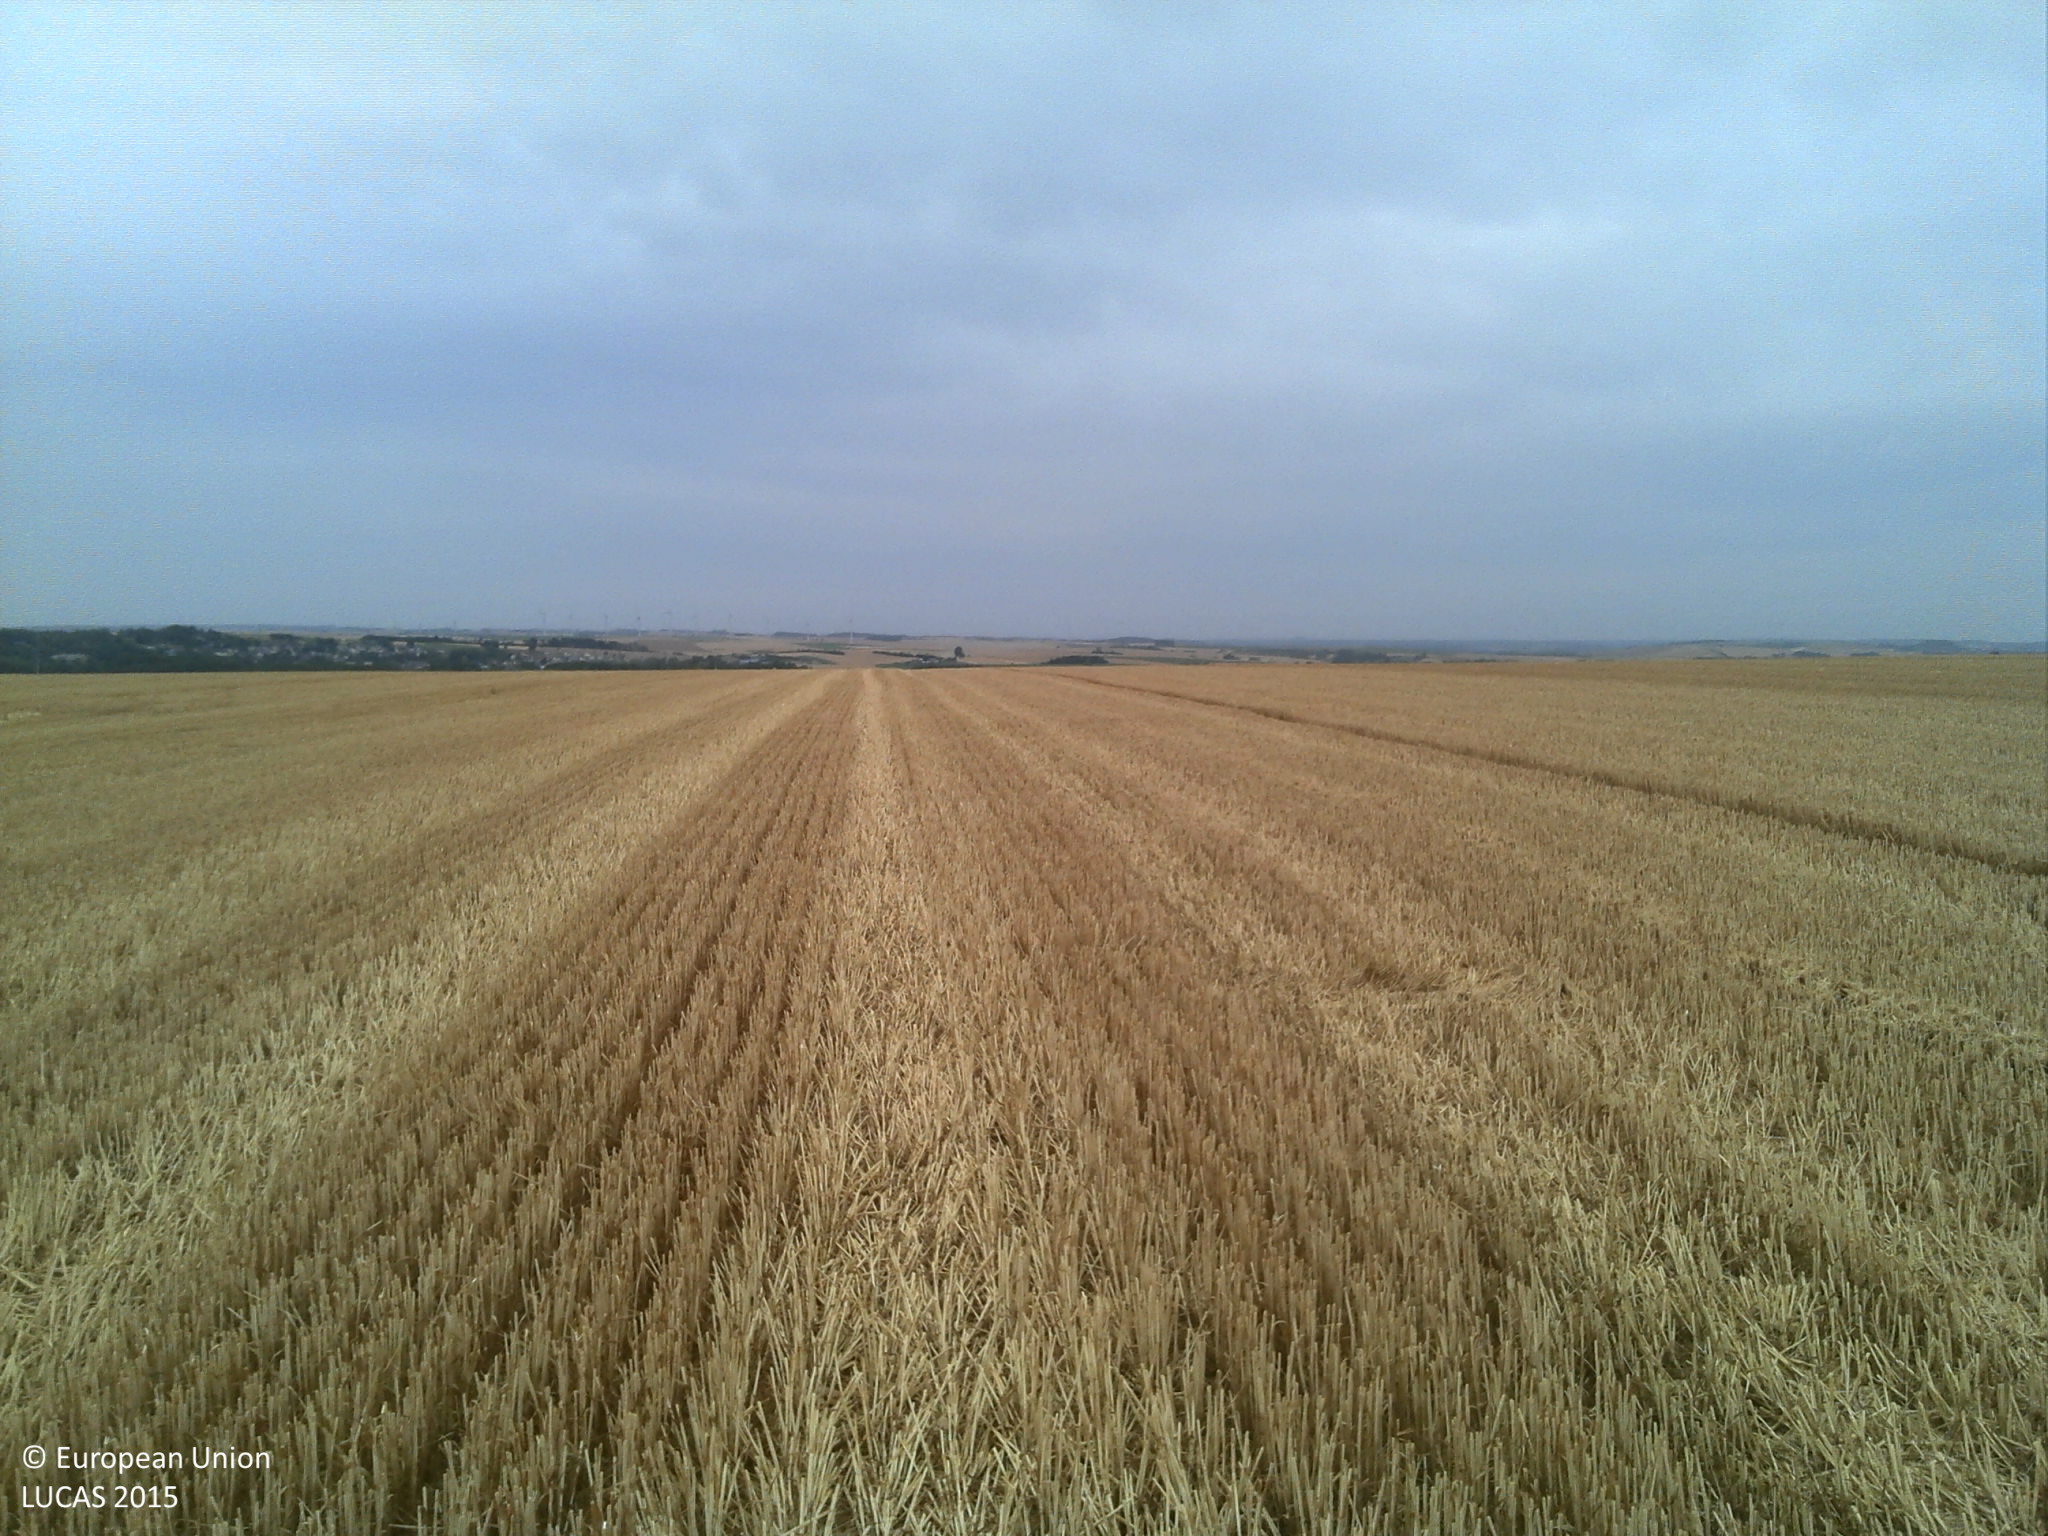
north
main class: Cropland
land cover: Common wheat
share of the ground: > 75 %
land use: Agriculture (excluding fallow land and kitchen gardens)
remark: Harvested field
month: July
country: FR
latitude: 49.4991
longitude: 4.2654
